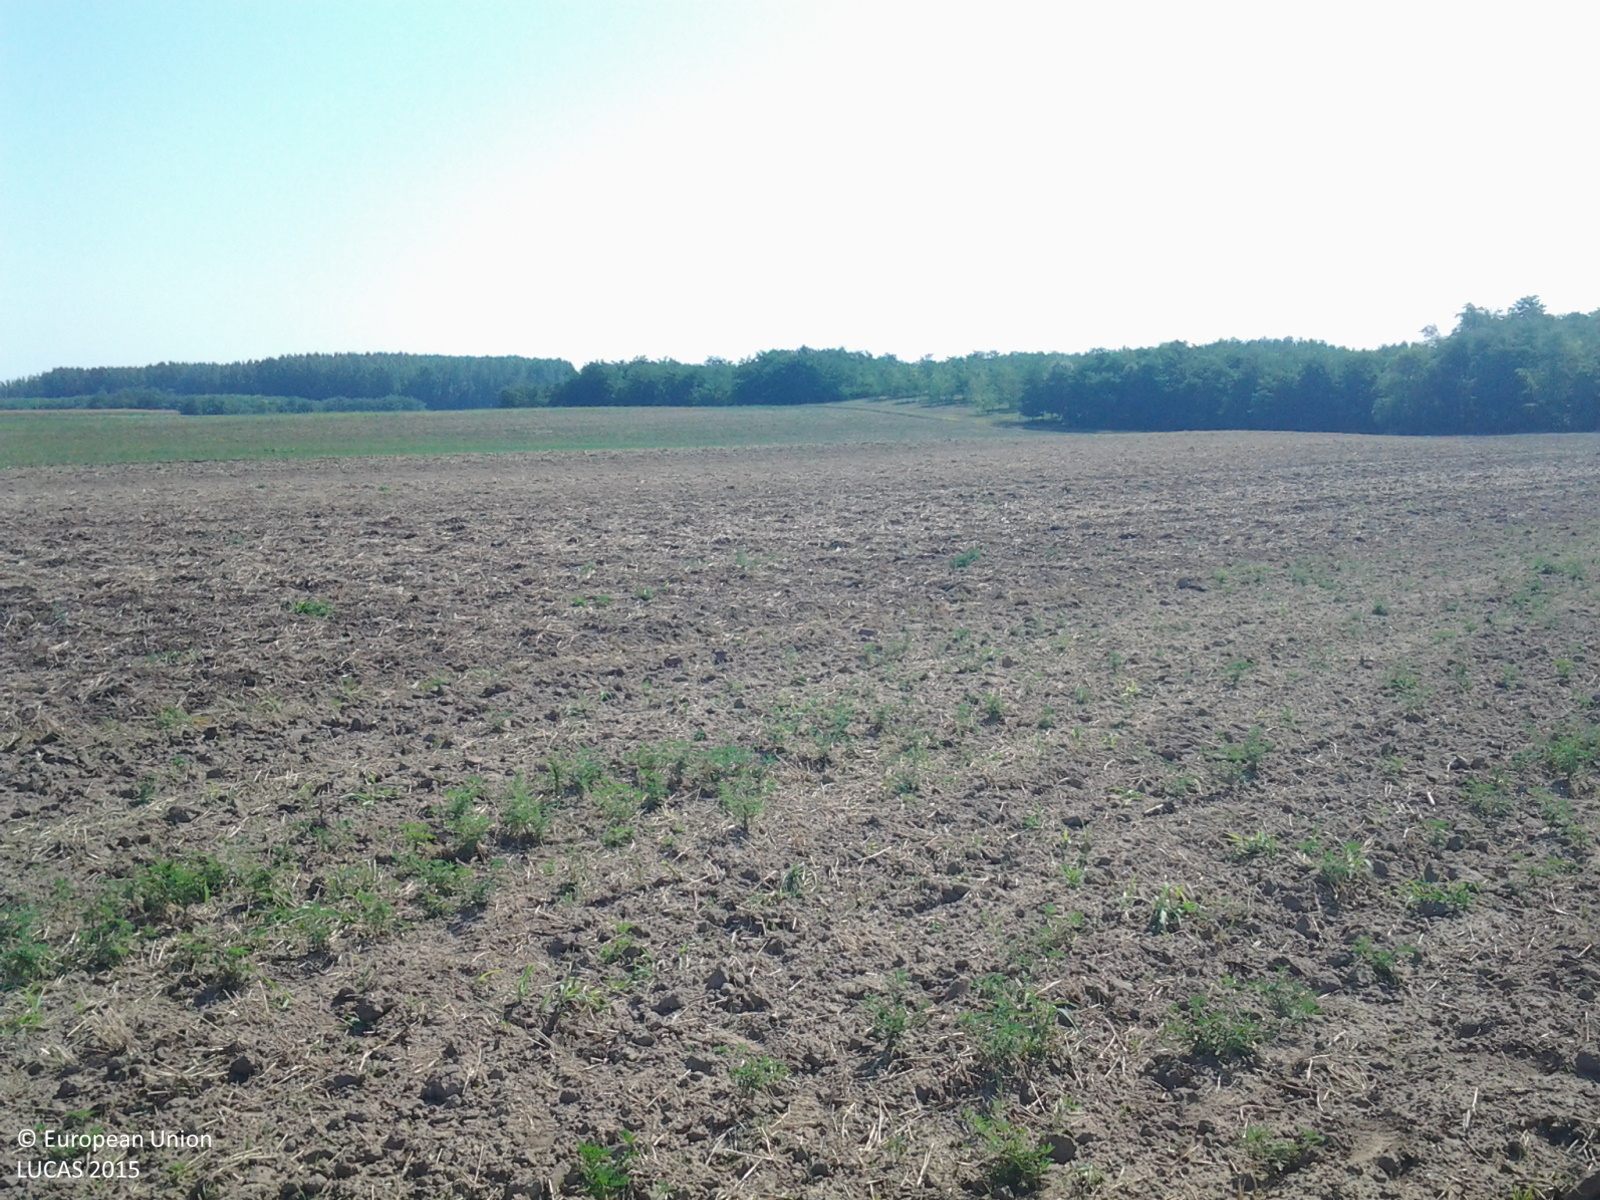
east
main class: Cropland
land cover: Barley
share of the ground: < 10 %
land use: Agriculture (excluding fallow land and kitchen gardens)
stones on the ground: < 10 %
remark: Harvested field
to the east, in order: Barley; Common wheat
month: August
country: HU
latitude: 47.3633
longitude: 19.8622
